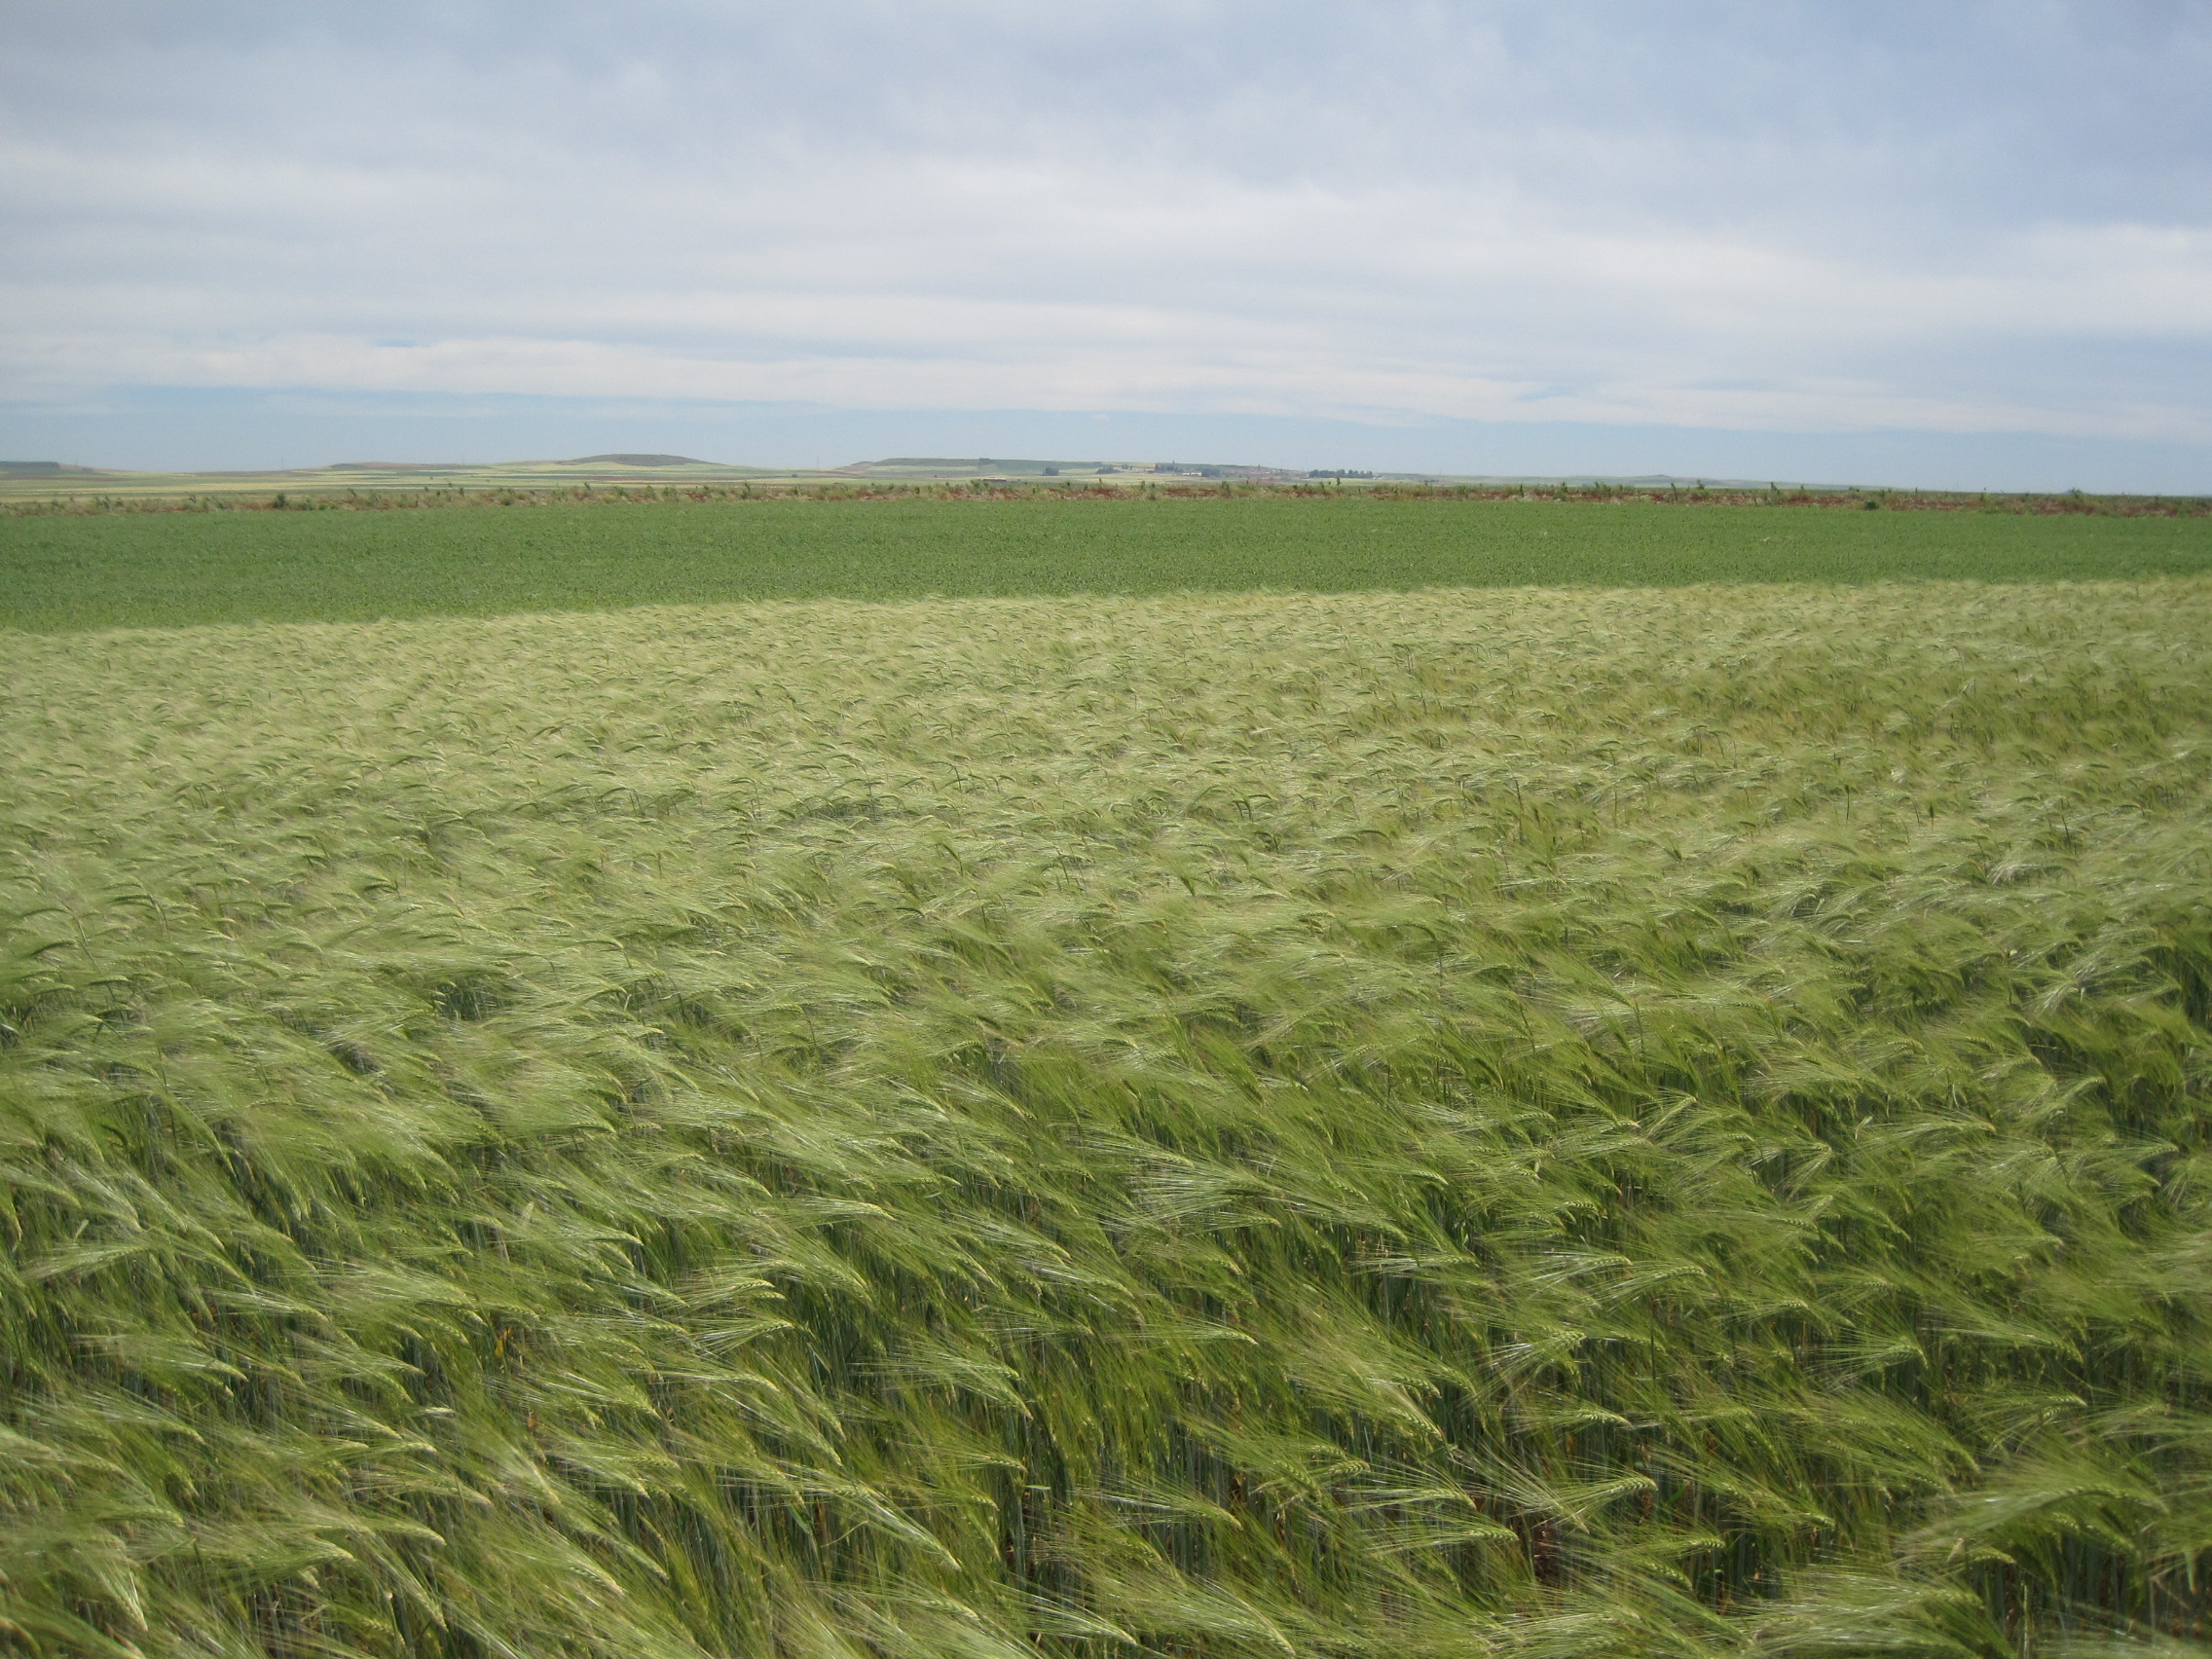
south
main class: Cropland
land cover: Barley
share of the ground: > 75 %
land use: Agriculture (excluding fallow land and kitchen gardens)
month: May
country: ES
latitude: 41.7133
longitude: -5.3577
